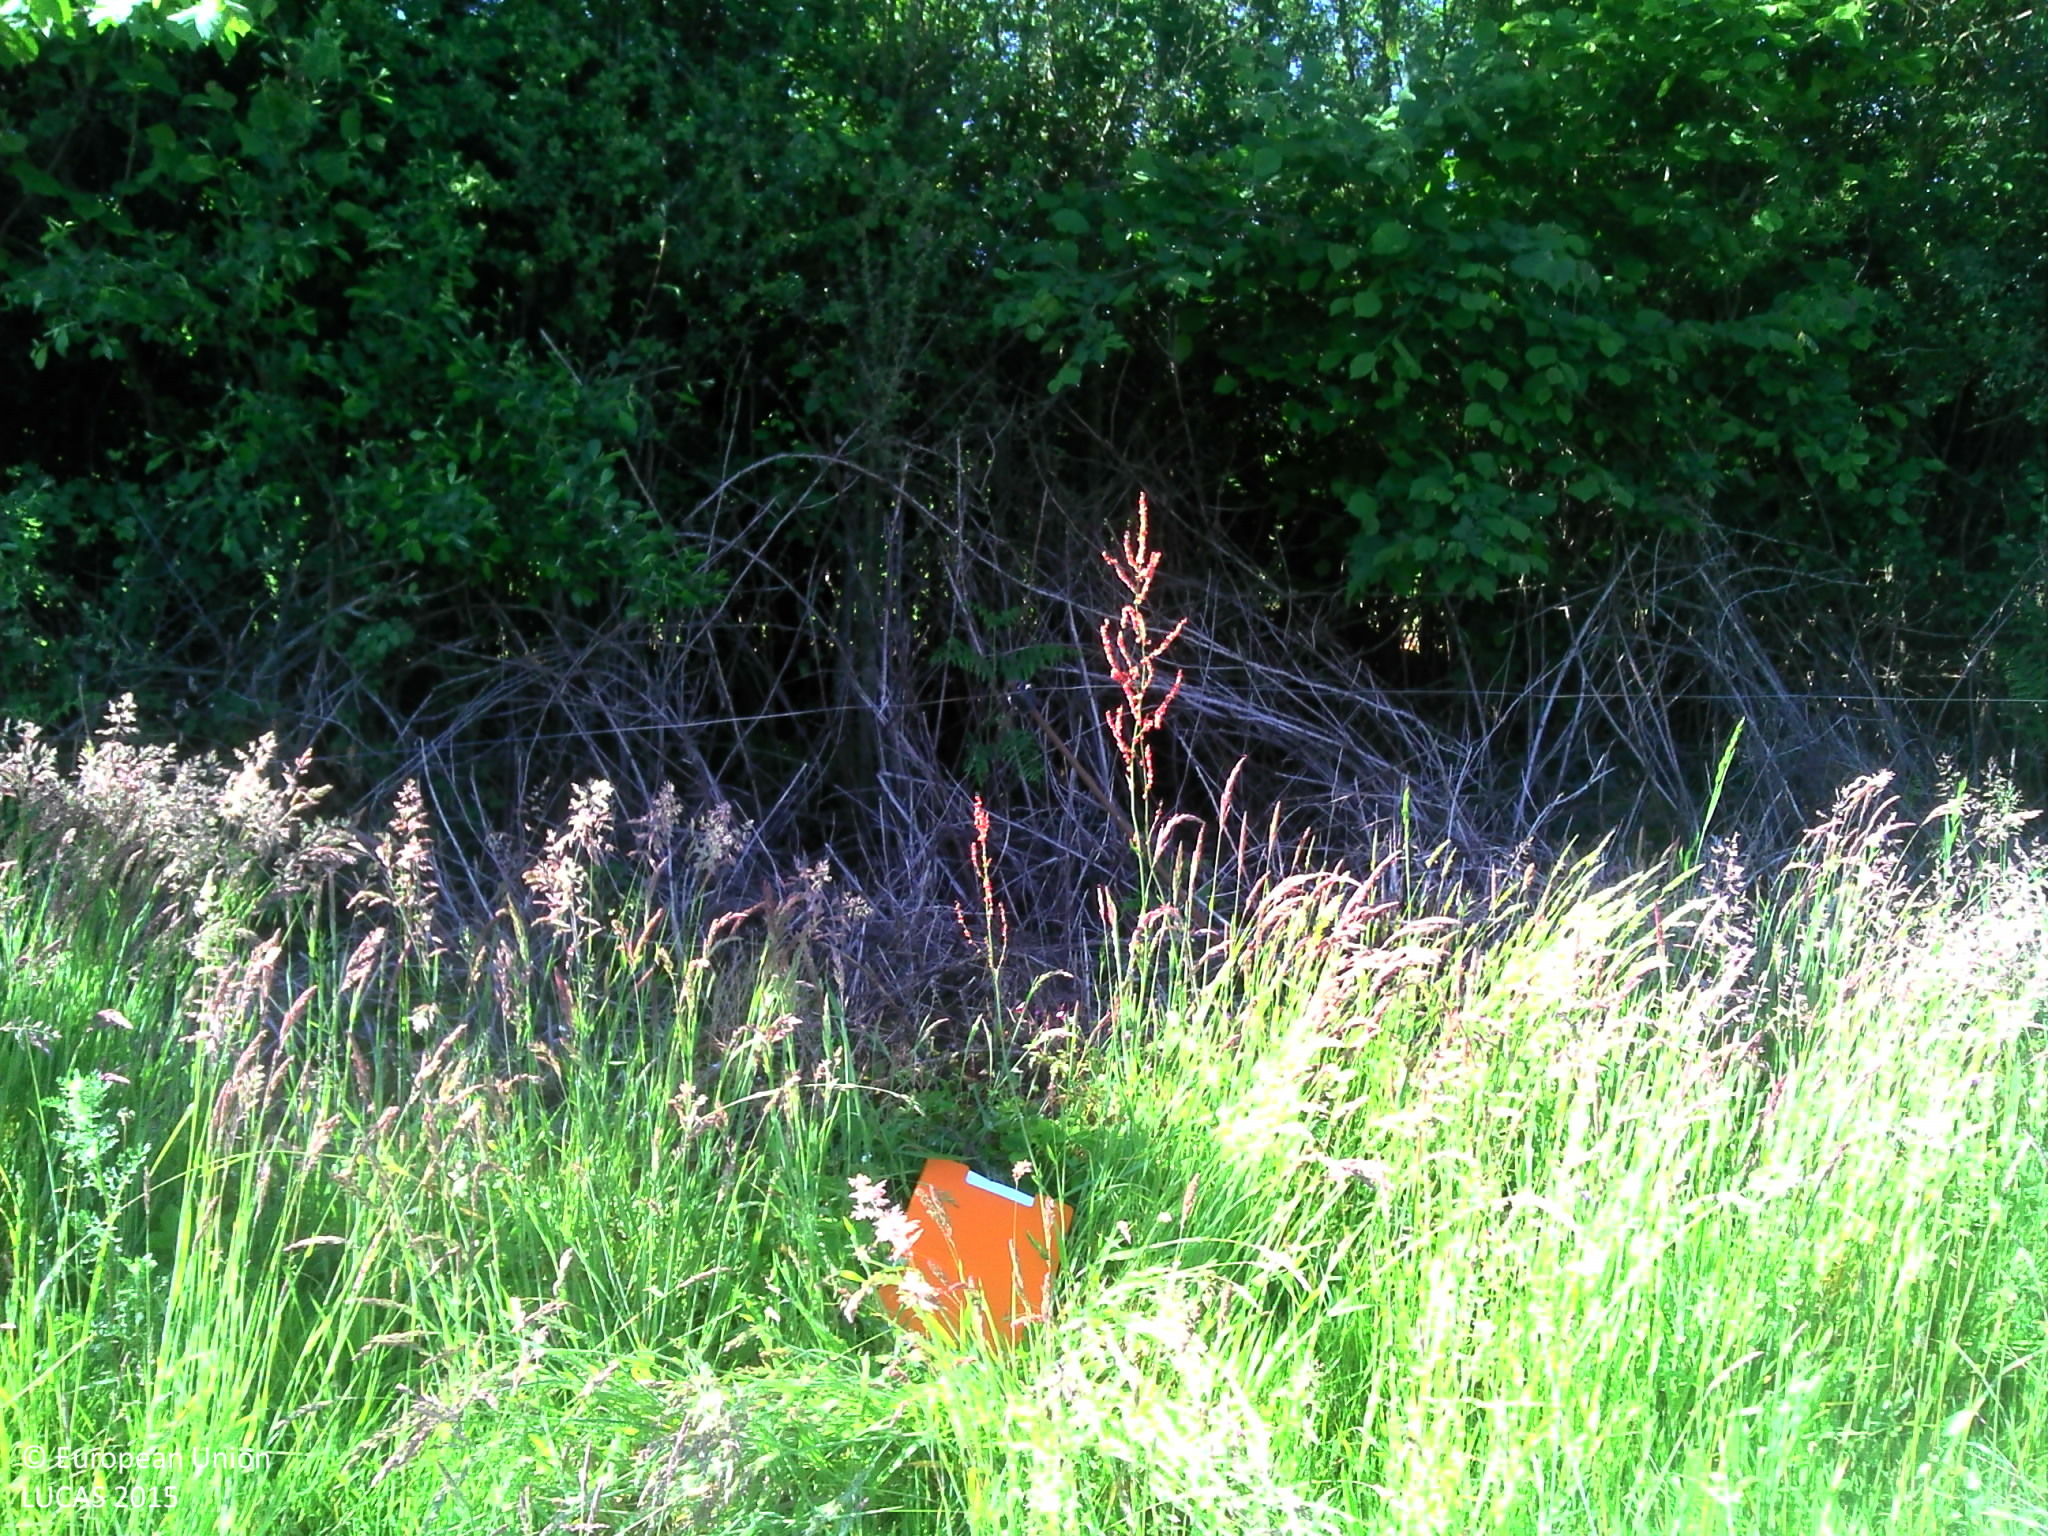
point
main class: Cropland
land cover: Triticale
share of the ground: > 75 %
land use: Agriculture (excluding fallow land and kitchen gardens)
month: June
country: FR
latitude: 46.4014
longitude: 2.3336
